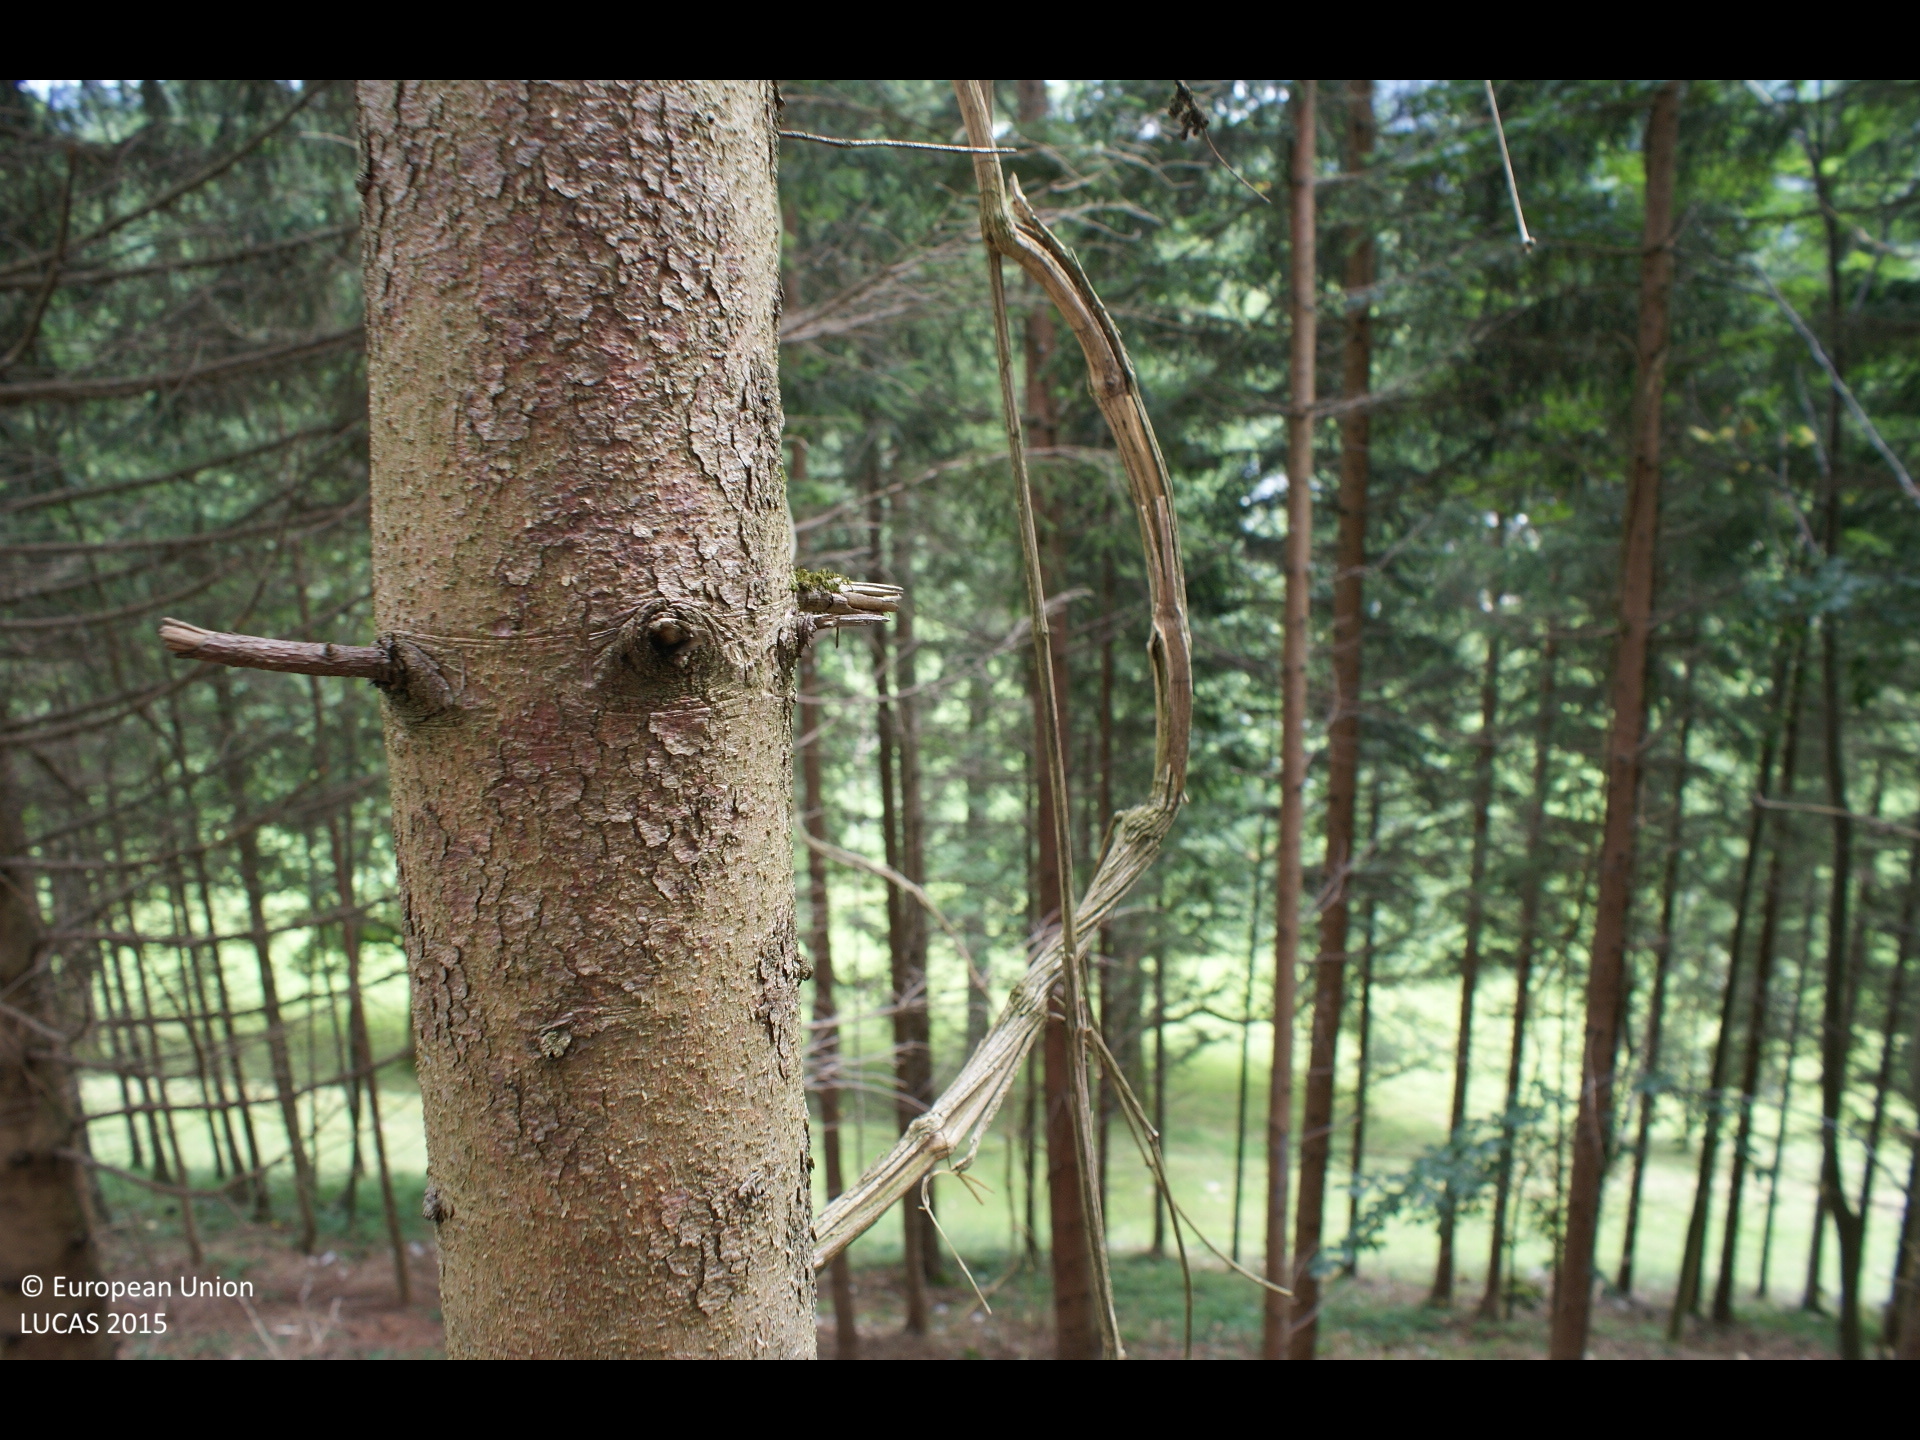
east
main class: Woodland
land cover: Spruce dominated coniferous woodland
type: alpine coniferous forest
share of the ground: > 75 %
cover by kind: coniferous forest trees 80 %, unconsolidated bare surface 10 %, broadleaved forest trees 5 %, herbaceous plants 5 %
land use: Forestry
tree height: > 5 m
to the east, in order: Spruce dominated coniferous woodland; Tracks; Broadleaved woodland; Grassland without tree/shrub cover; Fences; Grassland without tree/shrub cover; Single bushes/trees; Grassland without tree/shrub cover; Fences; Spruce dominated mixed woodland; Rivers and streams; Broadleaved woodland; Spruce dominated mixed woodland
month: July
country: AT
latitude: 47.7878
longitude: 14.9525
